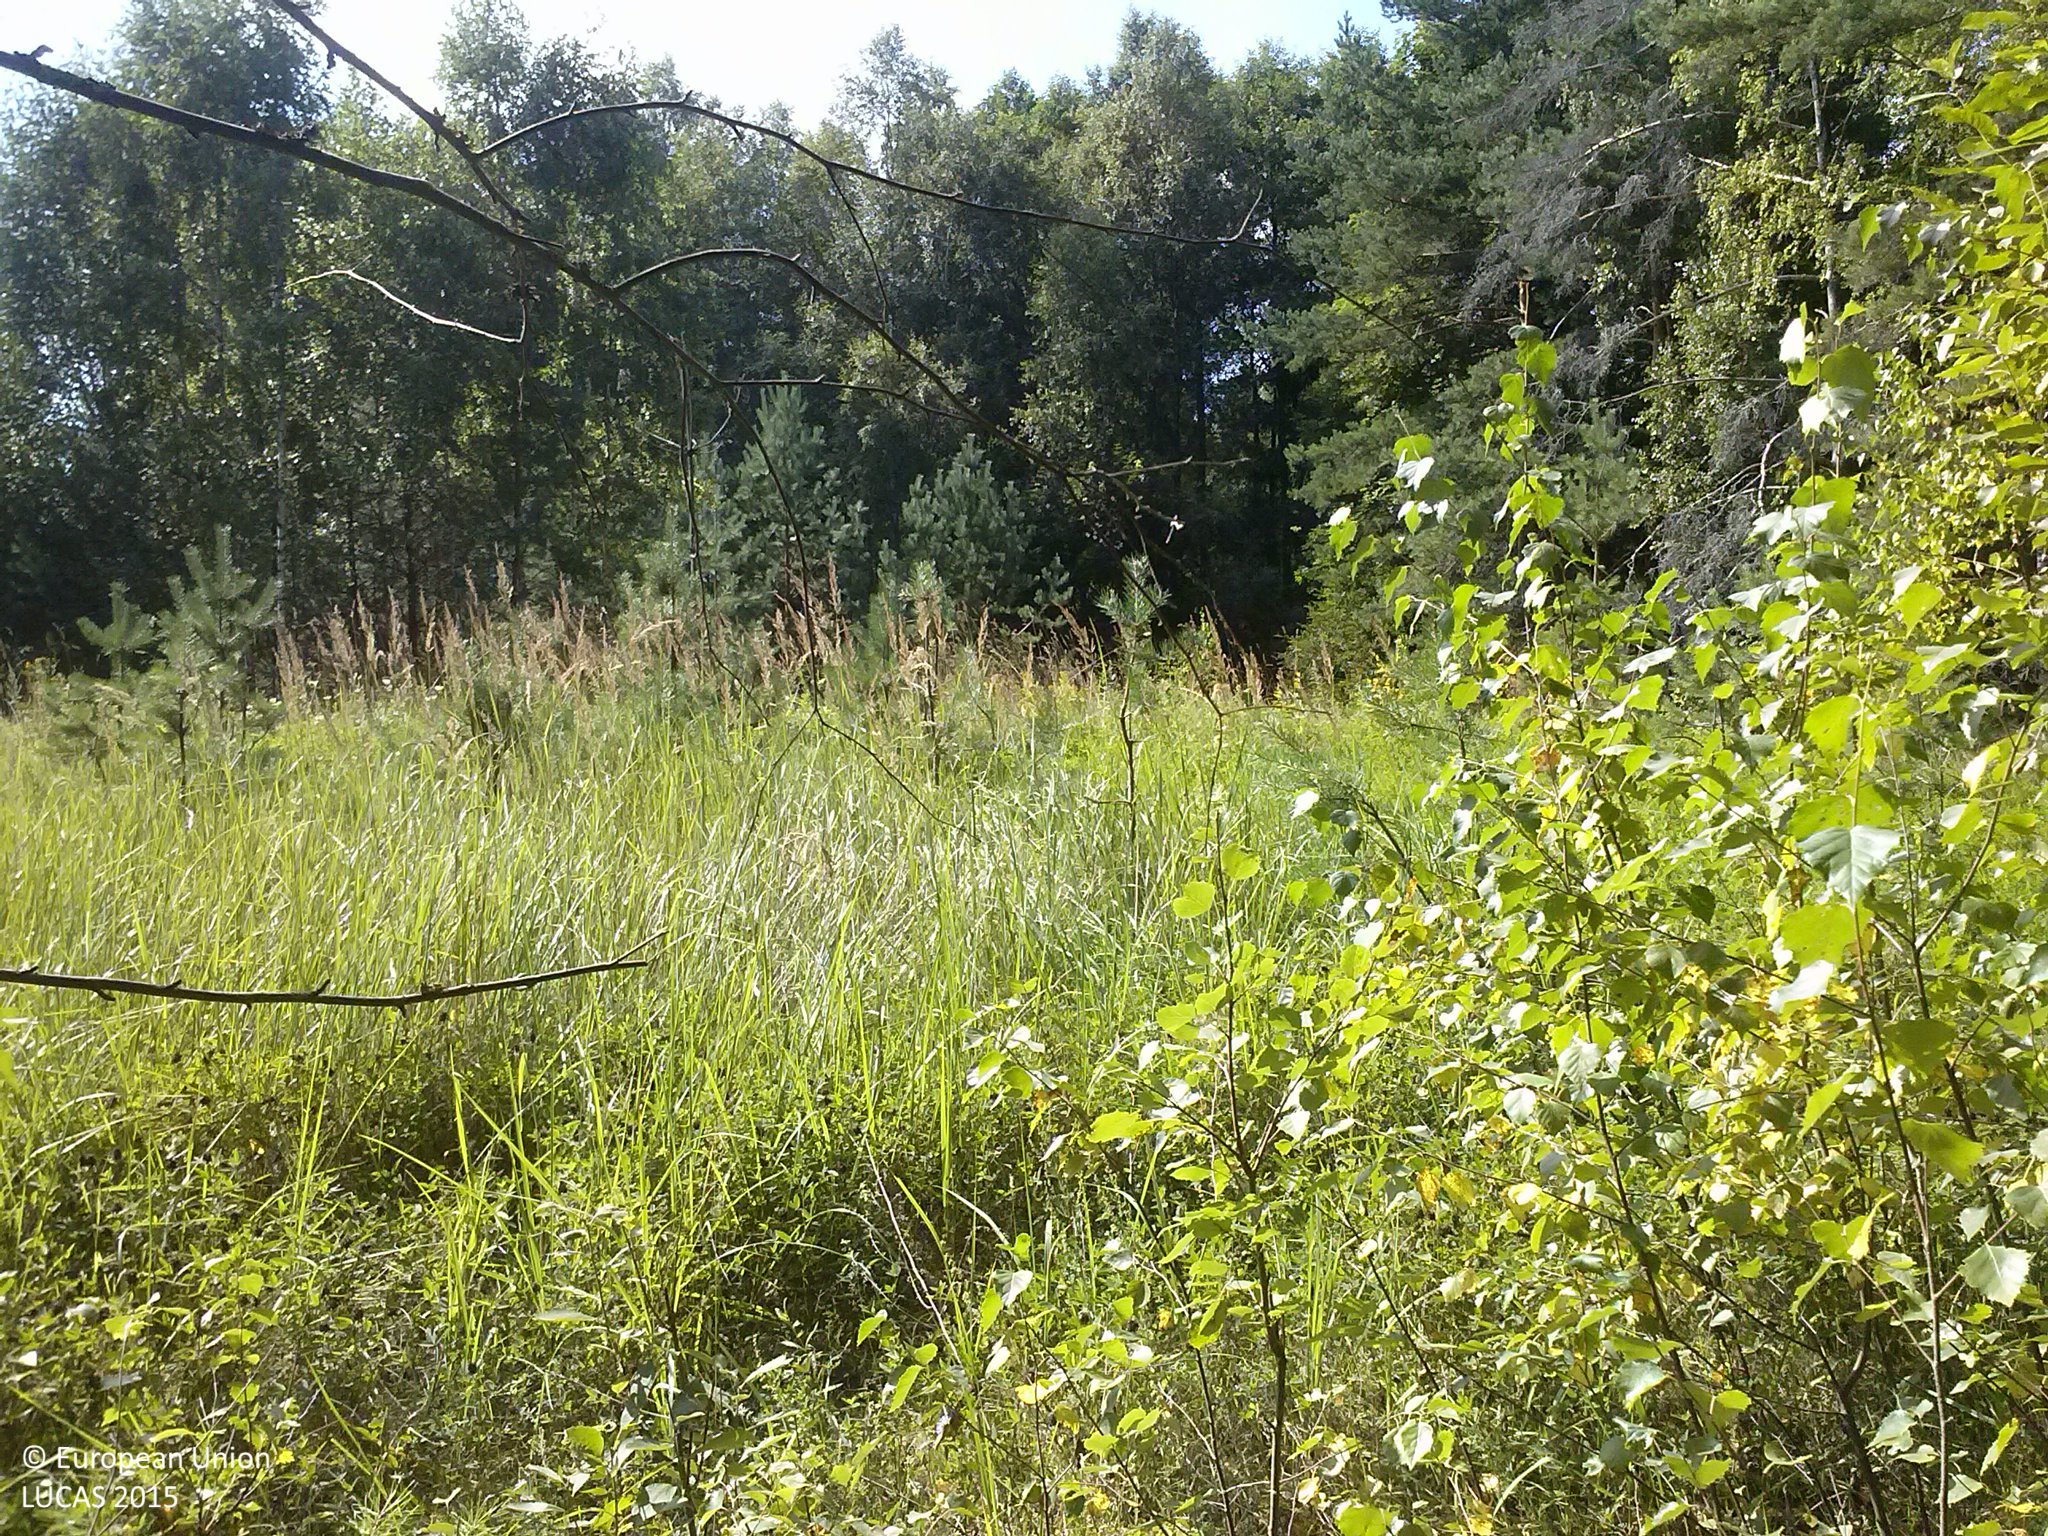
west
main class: Woodland
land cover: Pine dominated mixed woodland
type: hemiboreal forest and nemoral coniferous forest and mixed broadleaved-coniferous forest
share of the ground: > 75 %
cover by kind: coniferous forest trees 50 %, broadleaved forest trees 25 %, herbaceous plants 15 %, shrubs 5 %, lichens and mosses 5 %
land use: Forestry
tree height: > 5 m
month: August
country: LV
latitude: 56.2346
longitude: 26.8906
